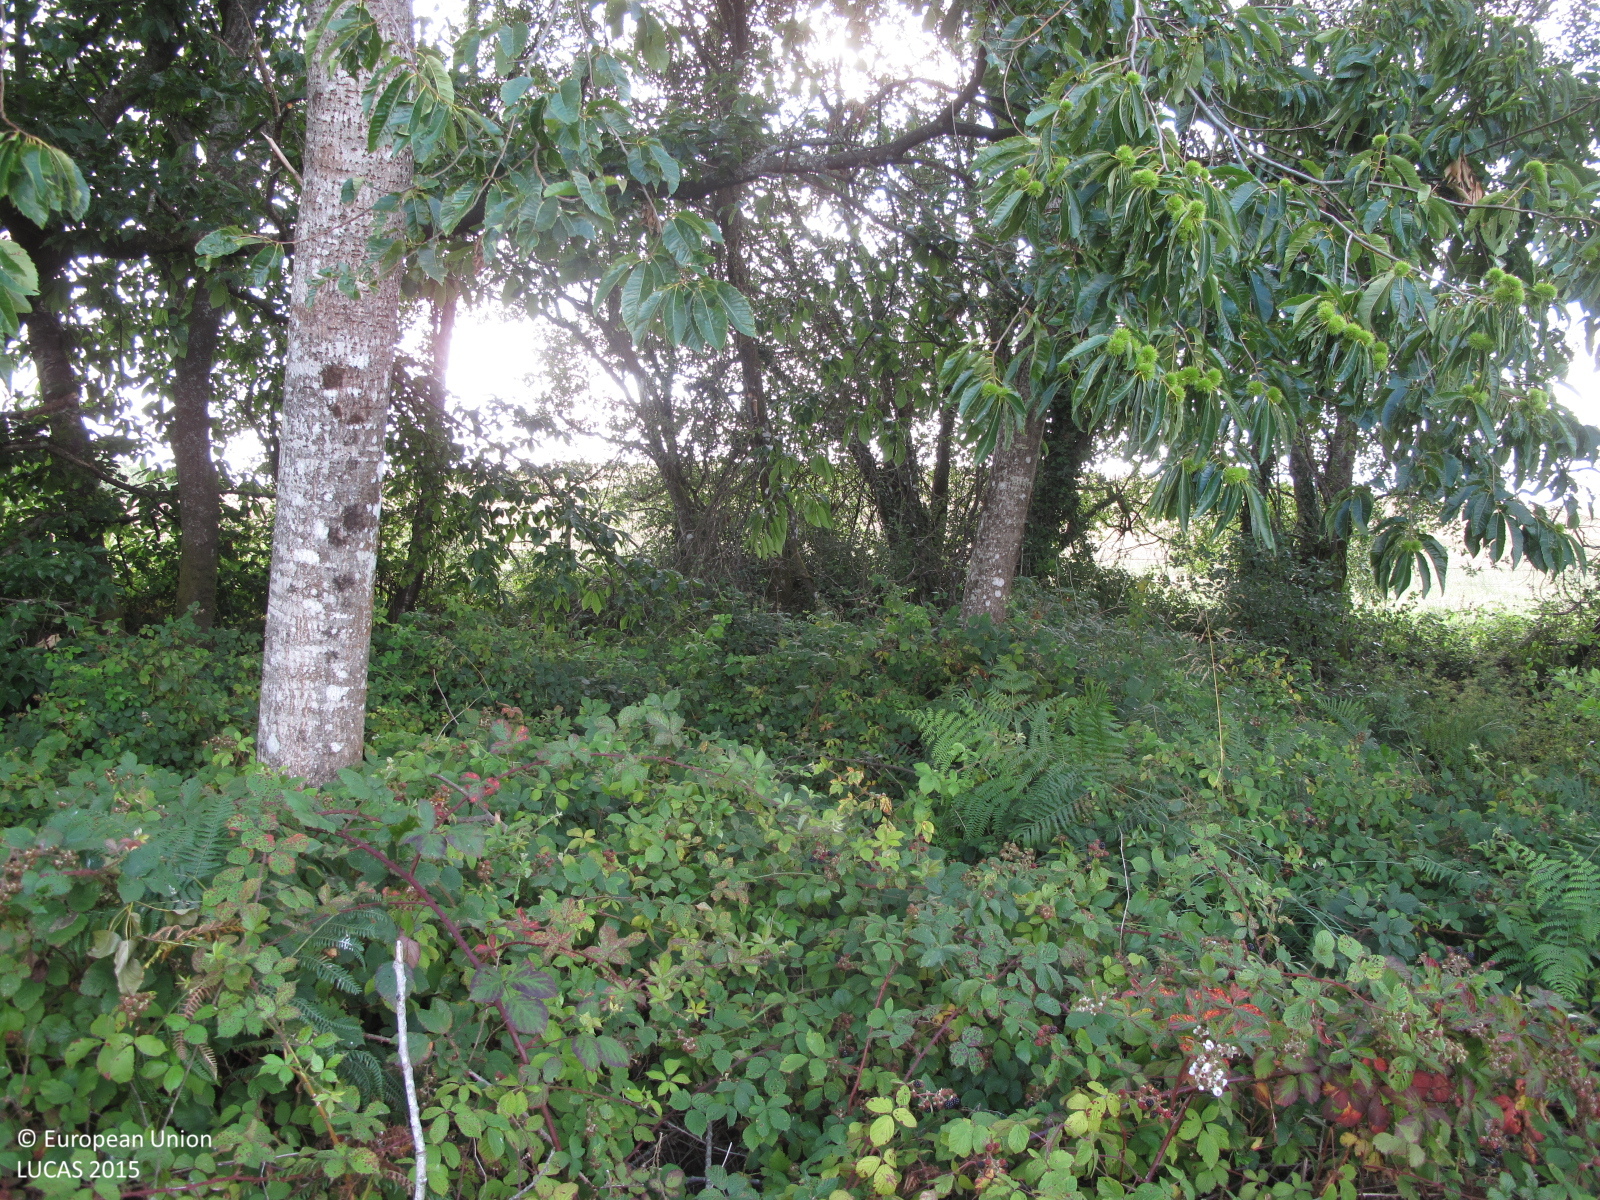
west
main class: Woodland
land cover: Broadleaved woodland
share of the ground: > 75 %
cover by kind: broadleaved forest trees 90 %, shrubs 10 %
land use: Semi-natural and natural areas not in use
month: July
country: ES
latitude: 43.1159
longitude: -7.9722
